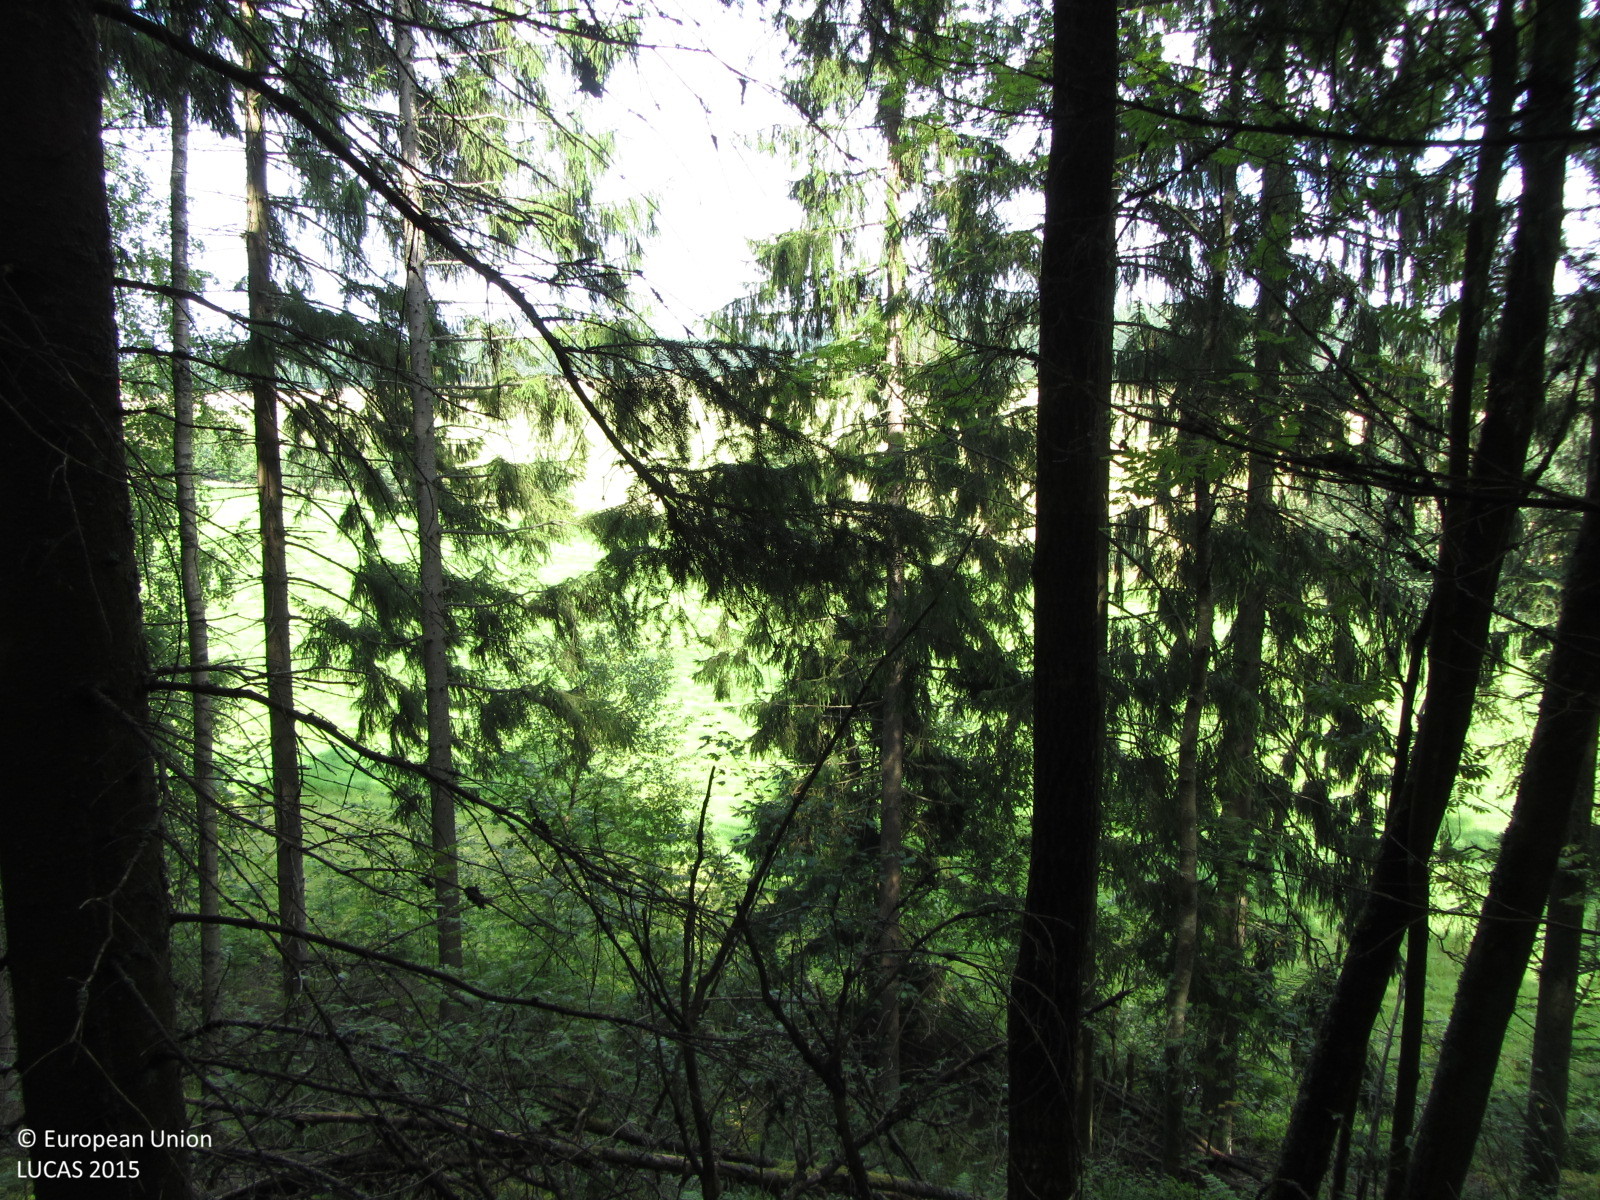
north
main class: Woodland
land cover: Spruce dominated mixed woodland
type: boreal forest
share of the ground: > 75 %
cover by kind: coniferous forest trees 50 %, broadleaved forest trees 40 %, shrubs 5 %, lichens and mosses 5 %
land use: Forestry
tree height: > 5 m
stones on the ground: < 10 %
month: August
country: FI
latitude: 60.1918
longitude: 24.1871
